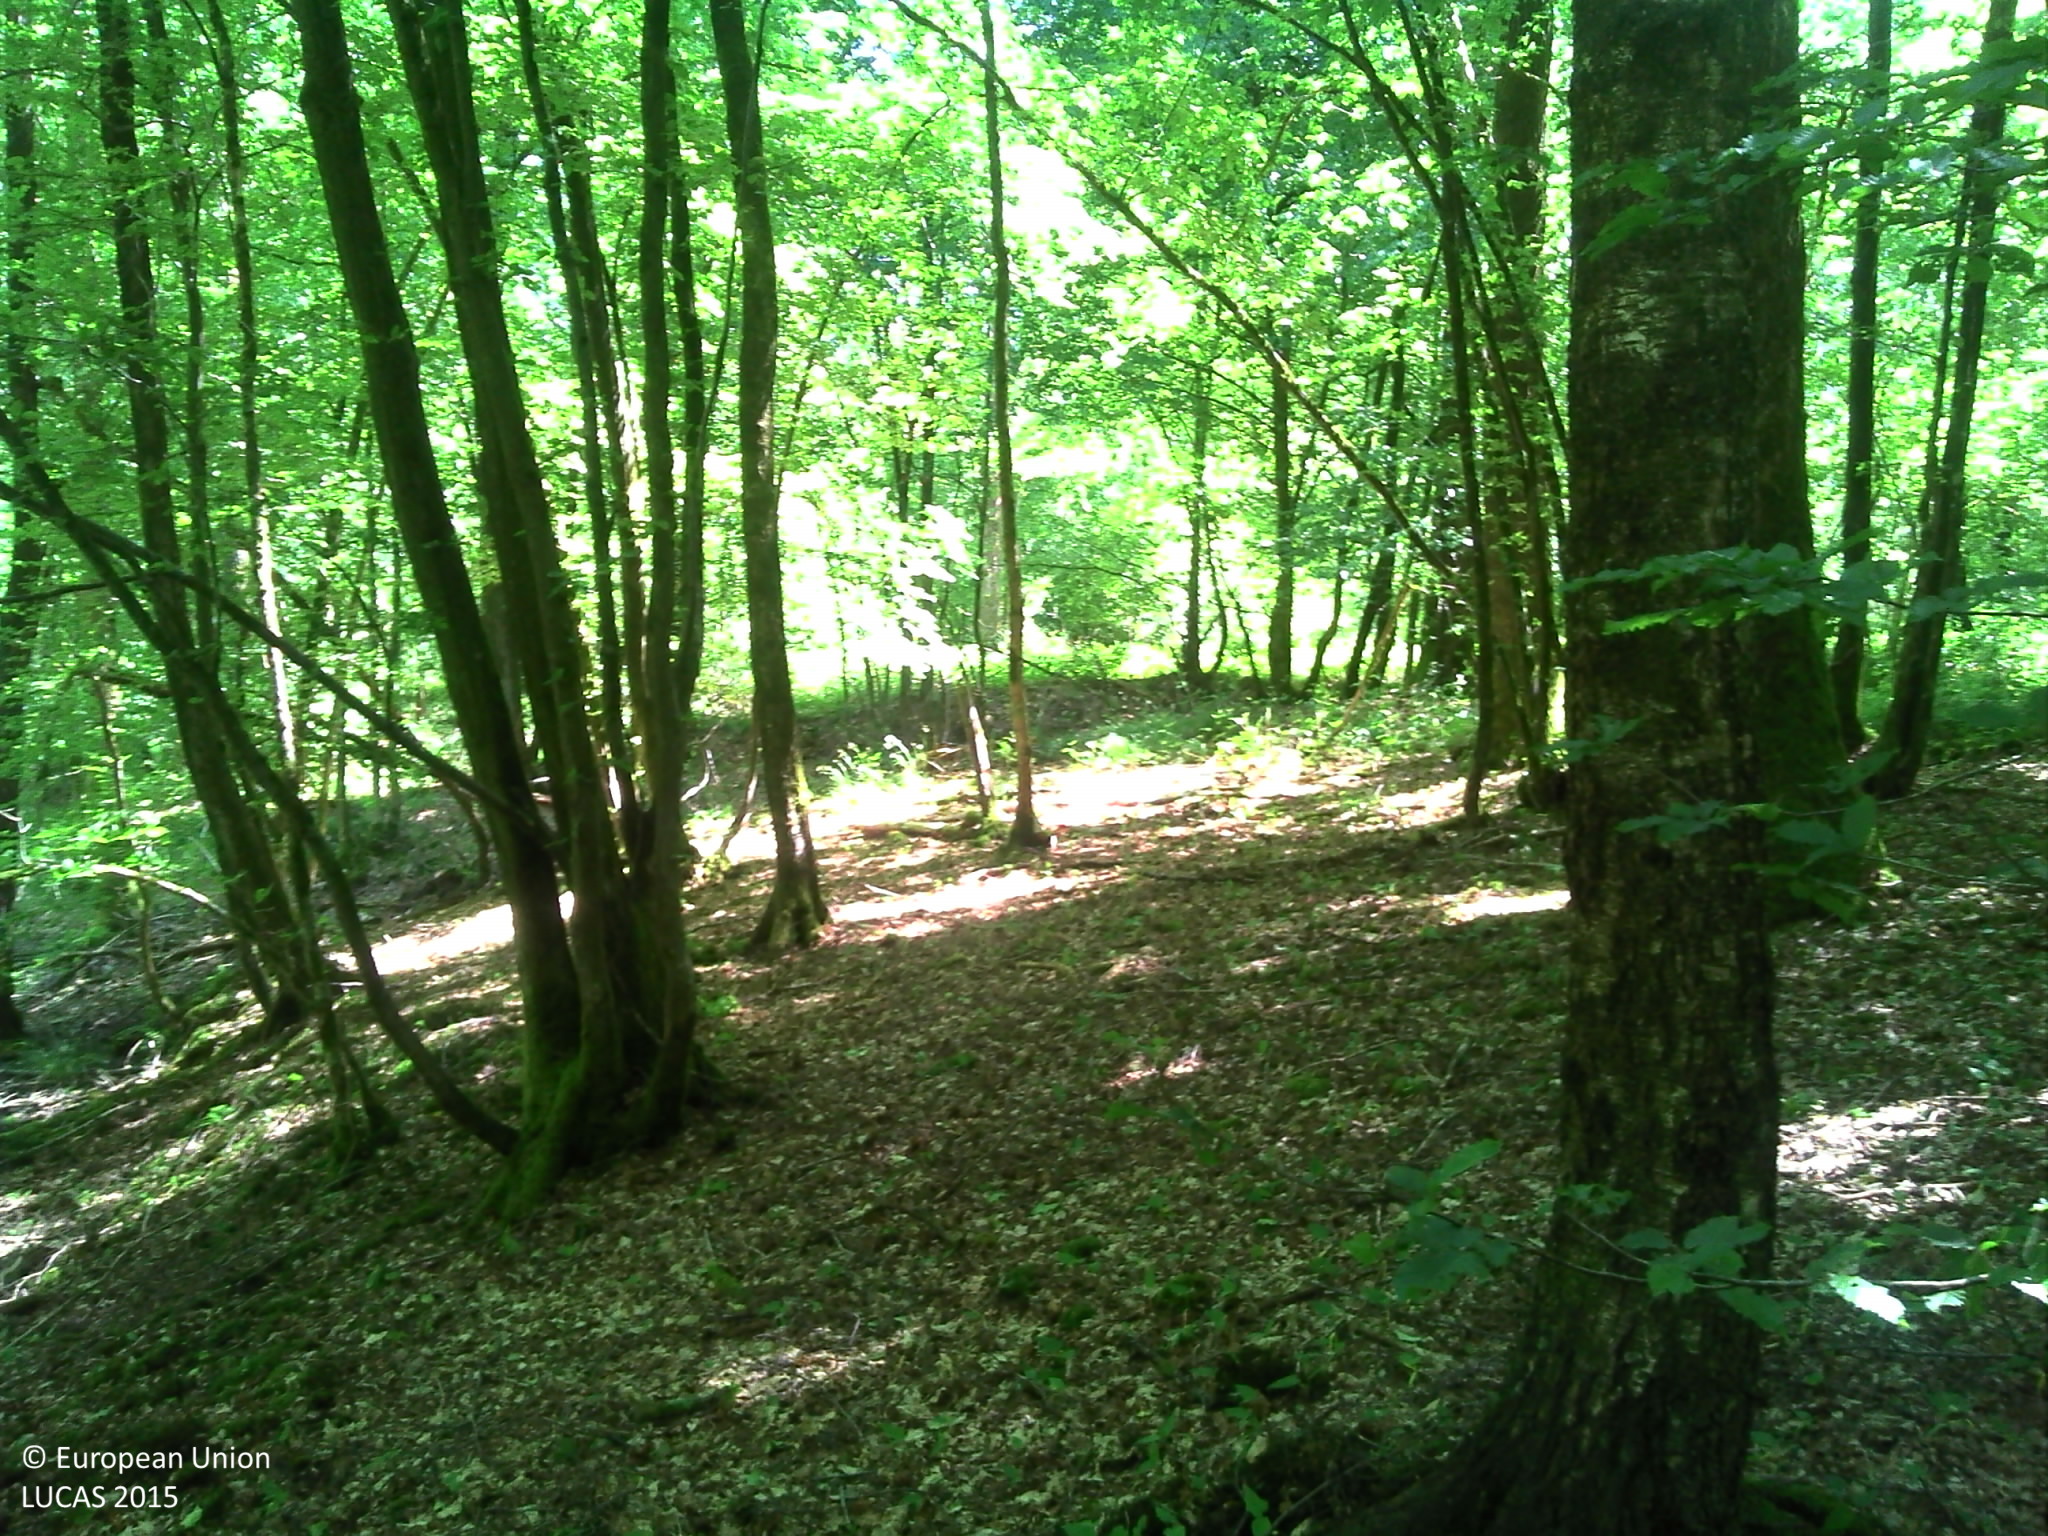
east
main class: Woodland
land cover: Broadleaved woodland
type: mesophytic deciduous forest
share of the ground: > 75 %
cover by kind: broadleaved forest trees 100 %
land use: Forestry
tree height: > 5 m
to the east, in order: Broadleaved woodland
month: June
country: FR
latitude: 49.9278
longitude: 4.1862
